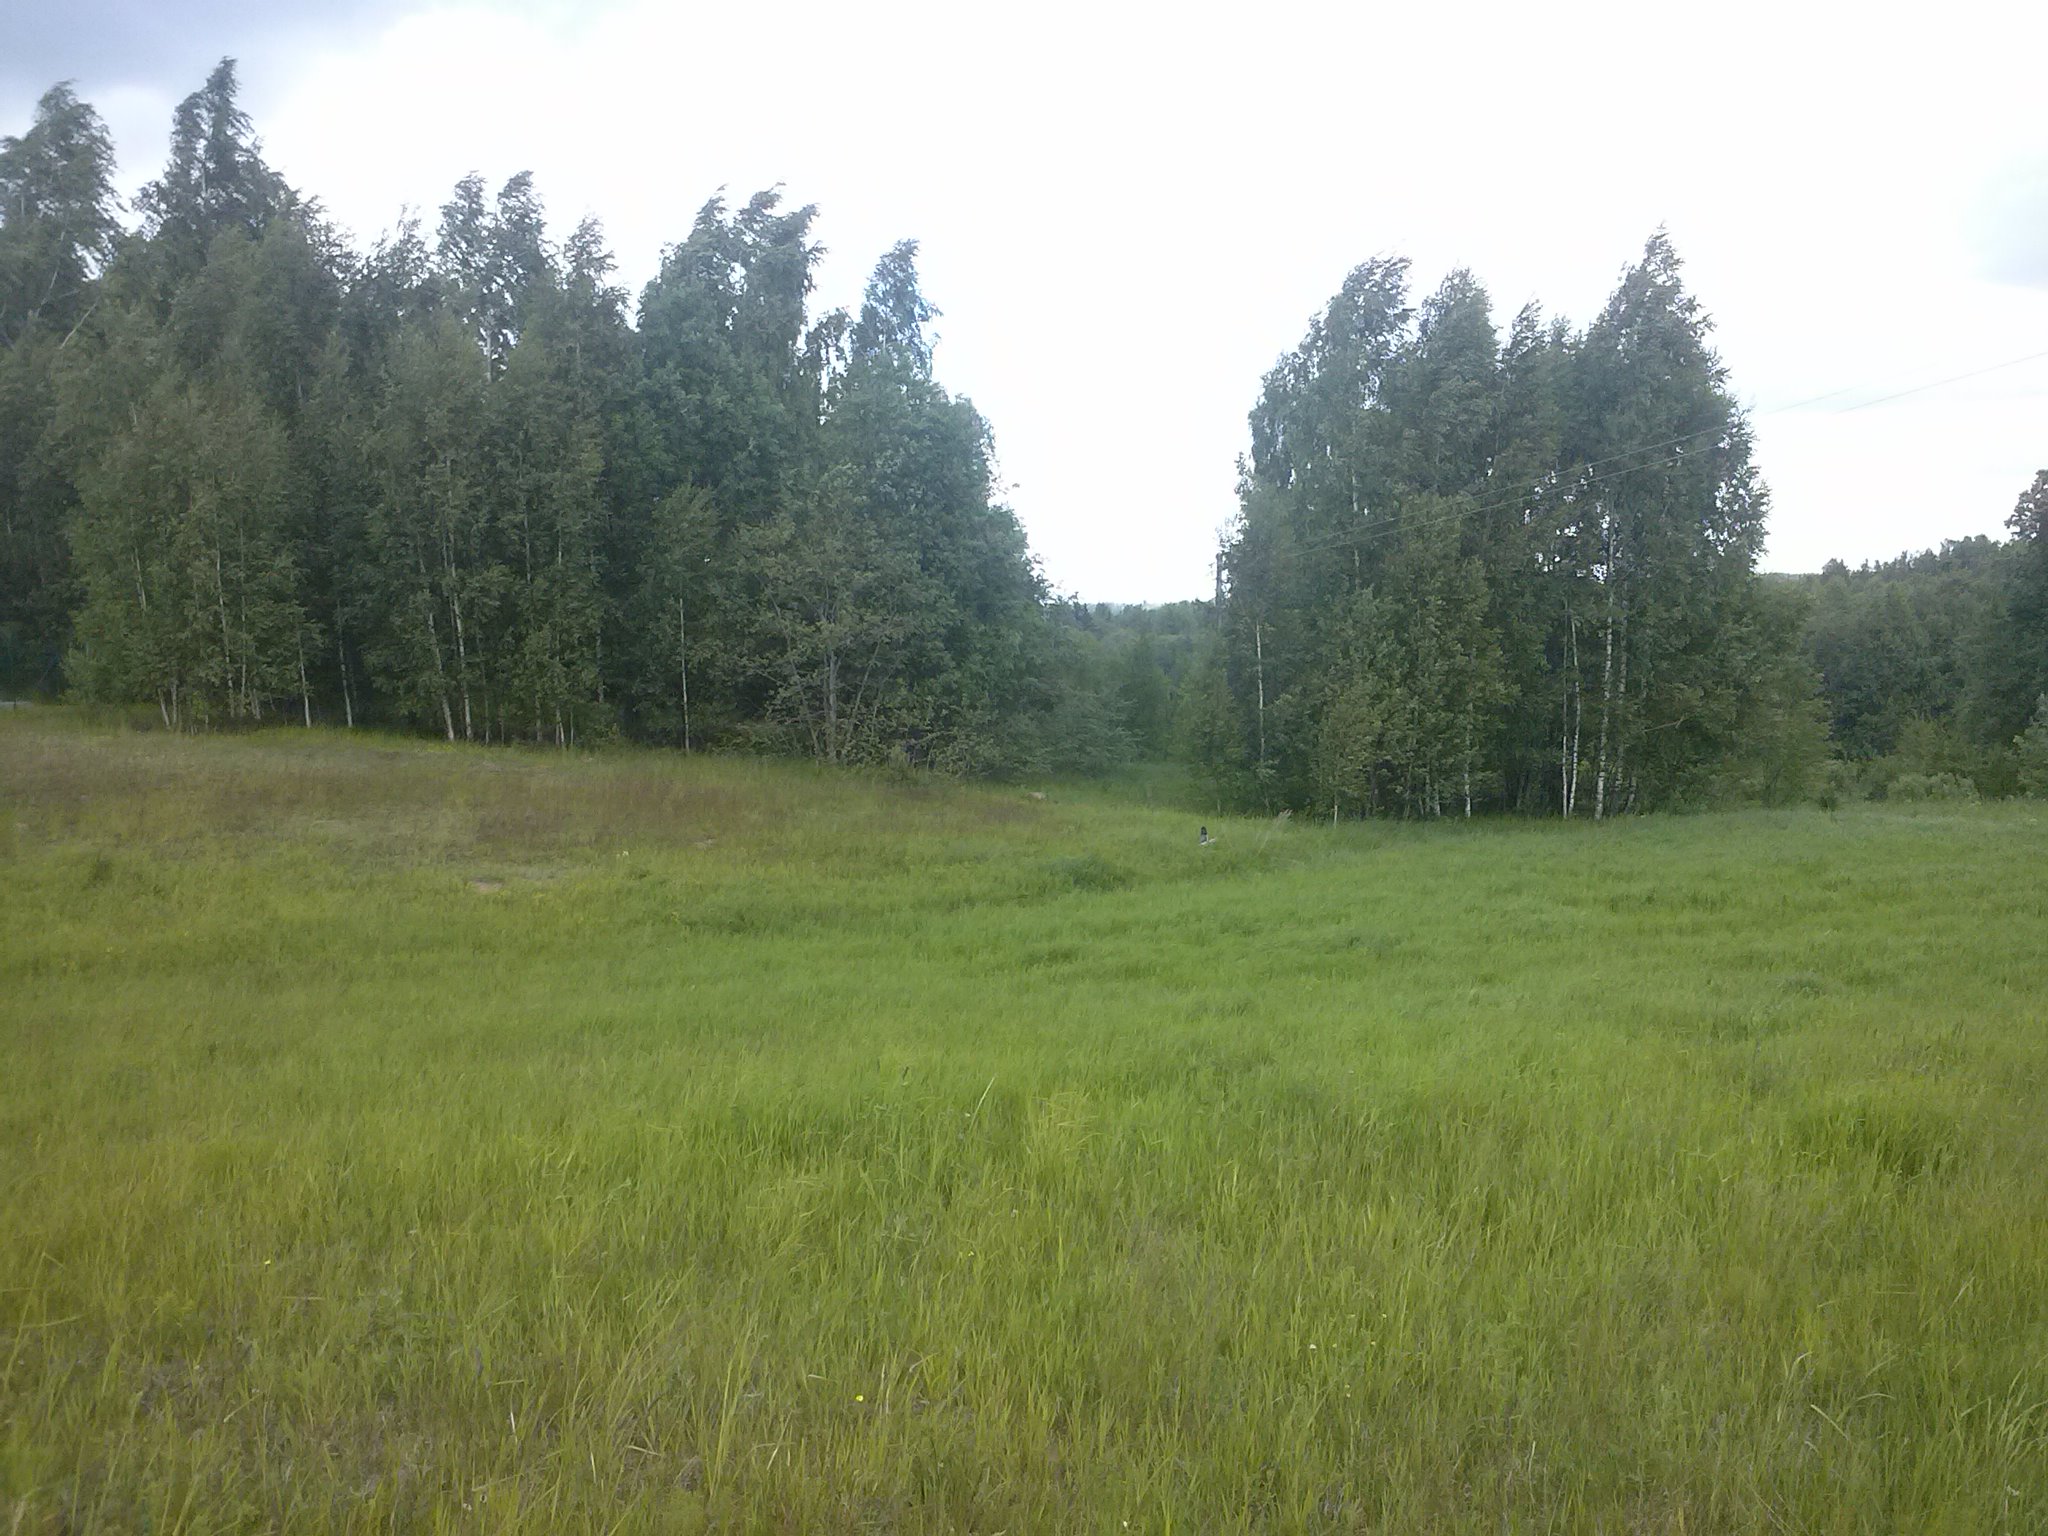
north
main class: Grassland
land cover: Grassland without tree/shrub cover
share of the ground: > 75 %
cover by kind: herbaceous plants 100 %
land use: Agriculture (excluding fallow land and kitchen gardens)
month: June
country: LV
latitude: 56.2663
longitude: 27.6055
